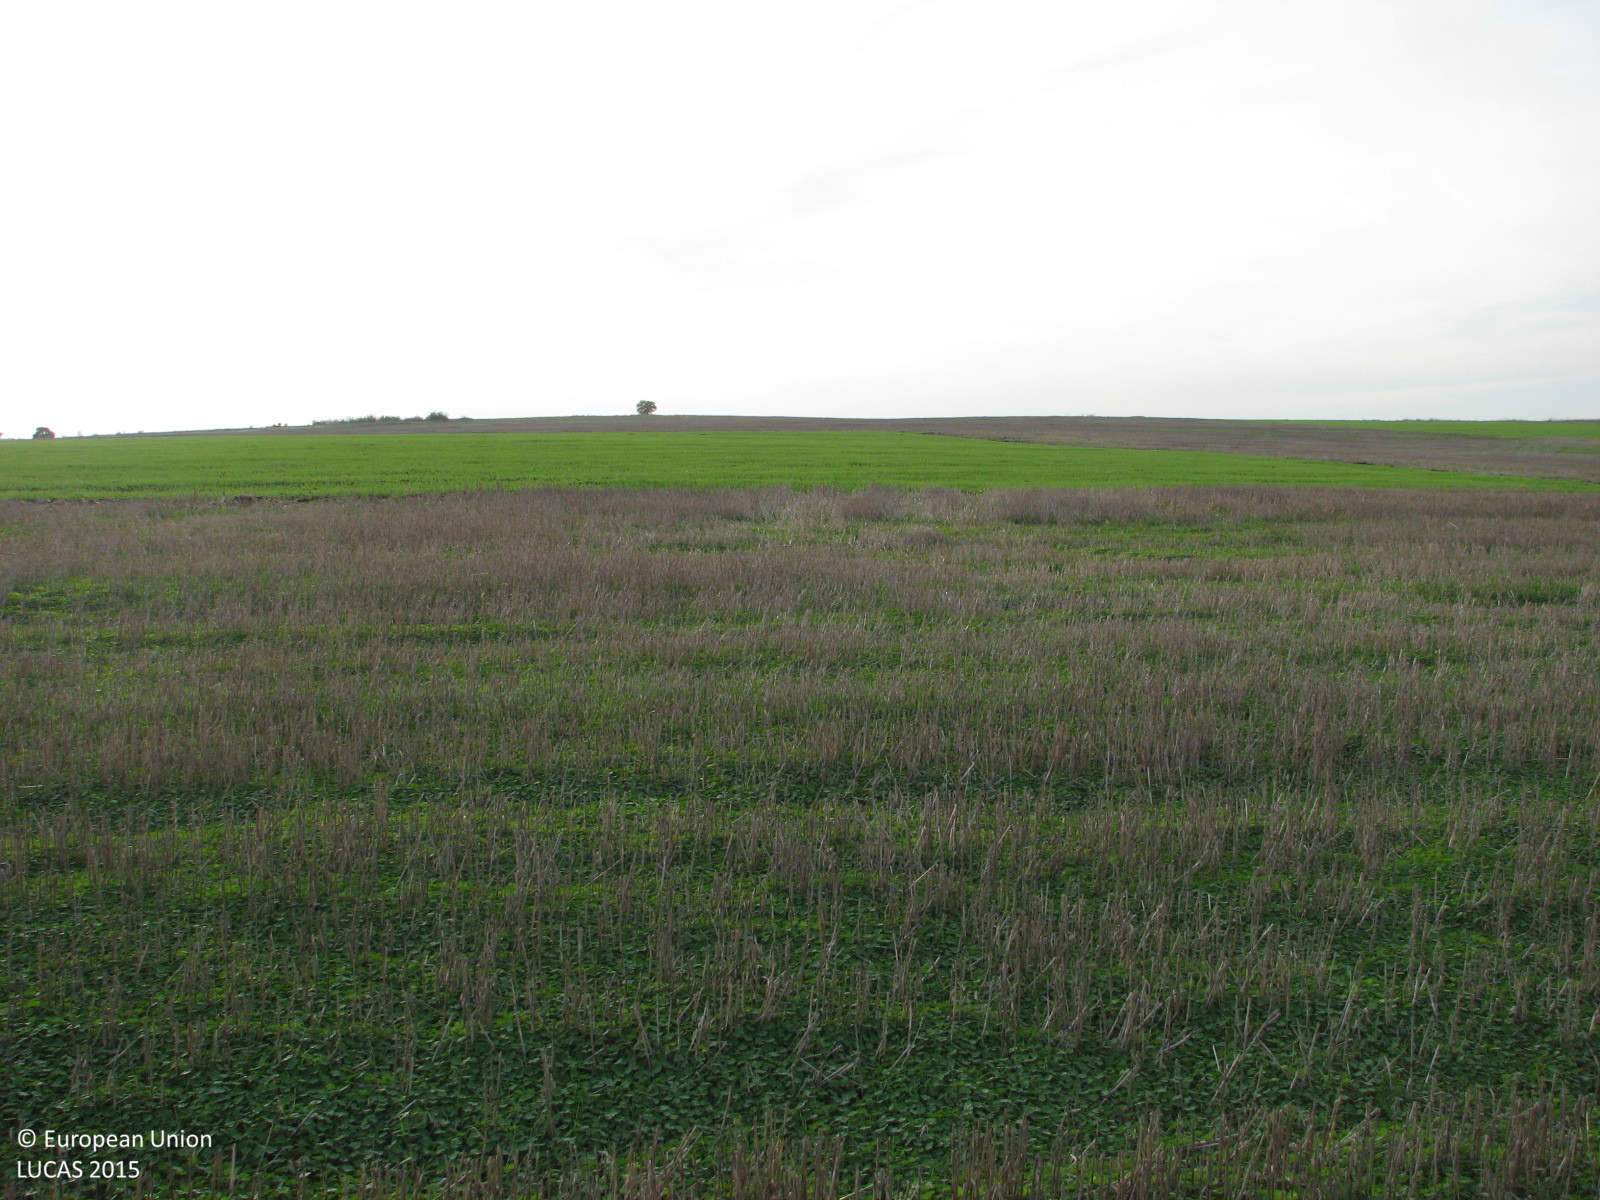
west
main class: Cropland
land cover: Common wheat
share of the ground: 25 - 50 %
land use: Agriculture (excluding fallow land and kitchen gardens)
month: October
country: BG
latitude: 42.4116
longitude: 26.8317
